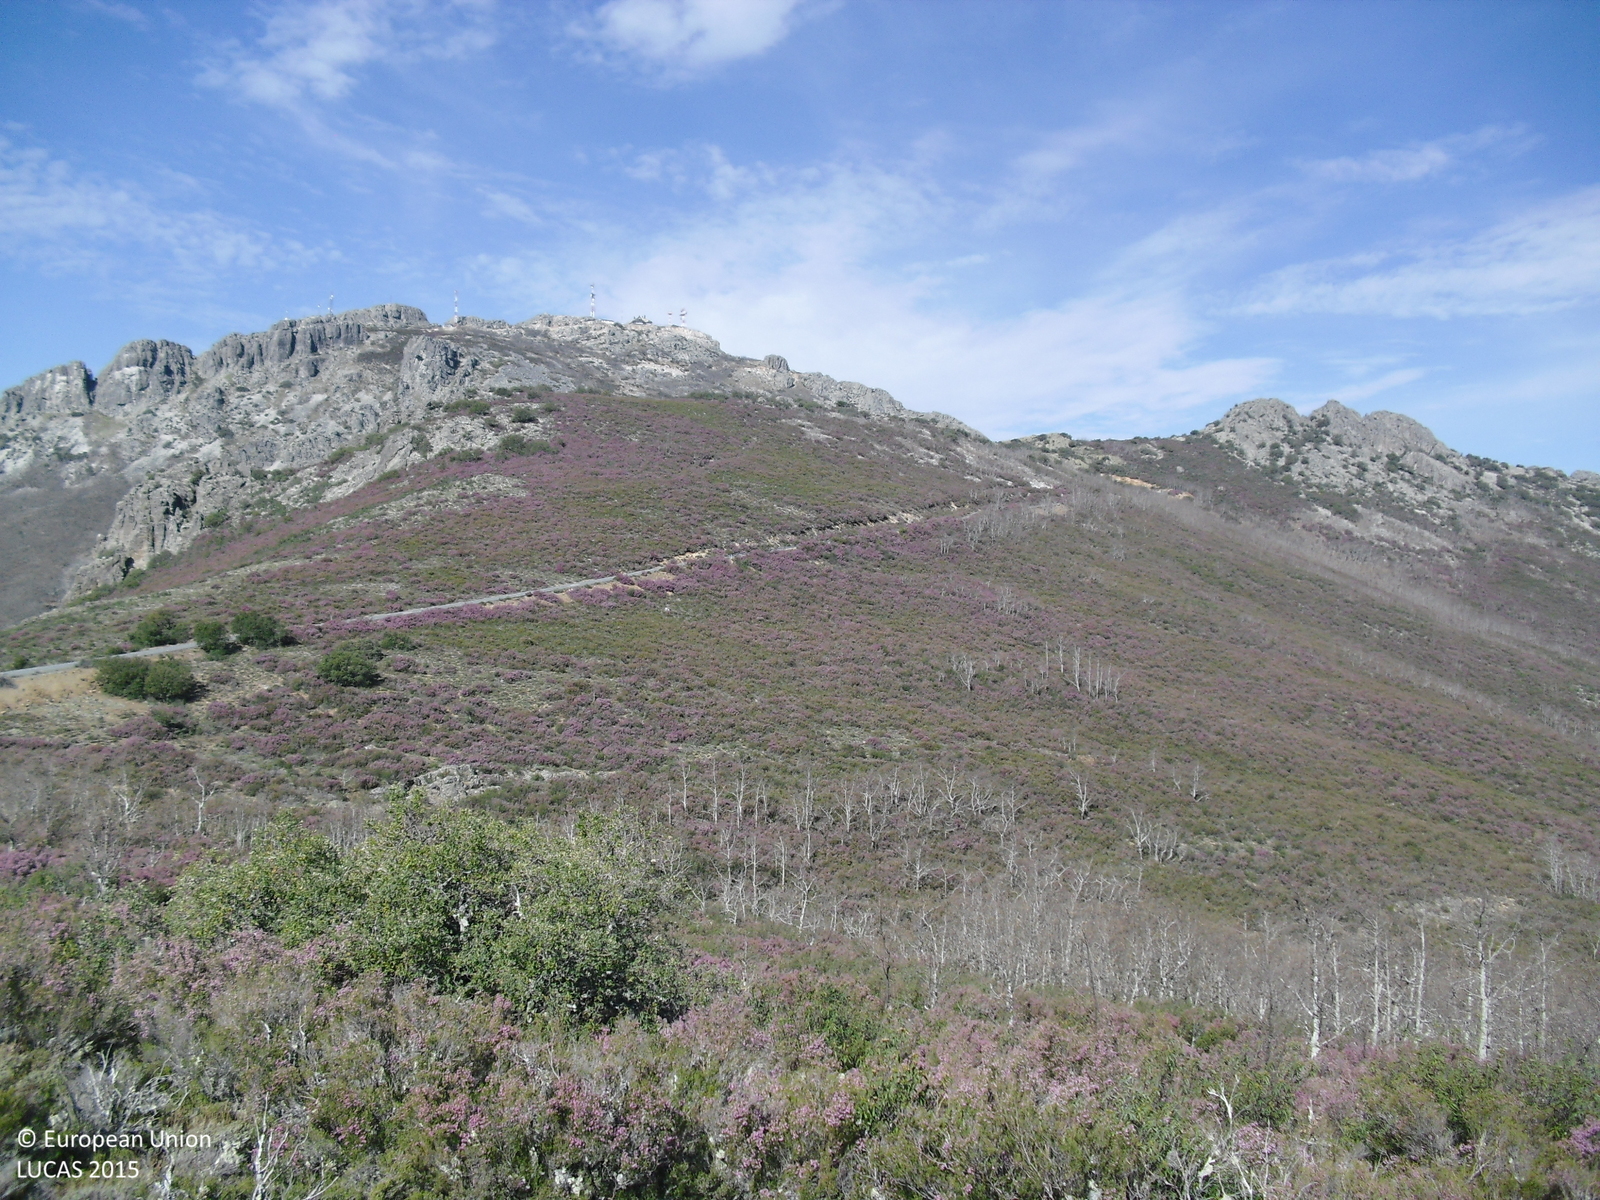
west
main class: Shrubland
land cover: Shrubland without tree cover
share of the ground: > 75 %
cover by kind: shrubs 100 %
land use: Semi-natural and natural areas not in use
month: April
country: ES
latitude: 39.4691
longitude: -5.3812
